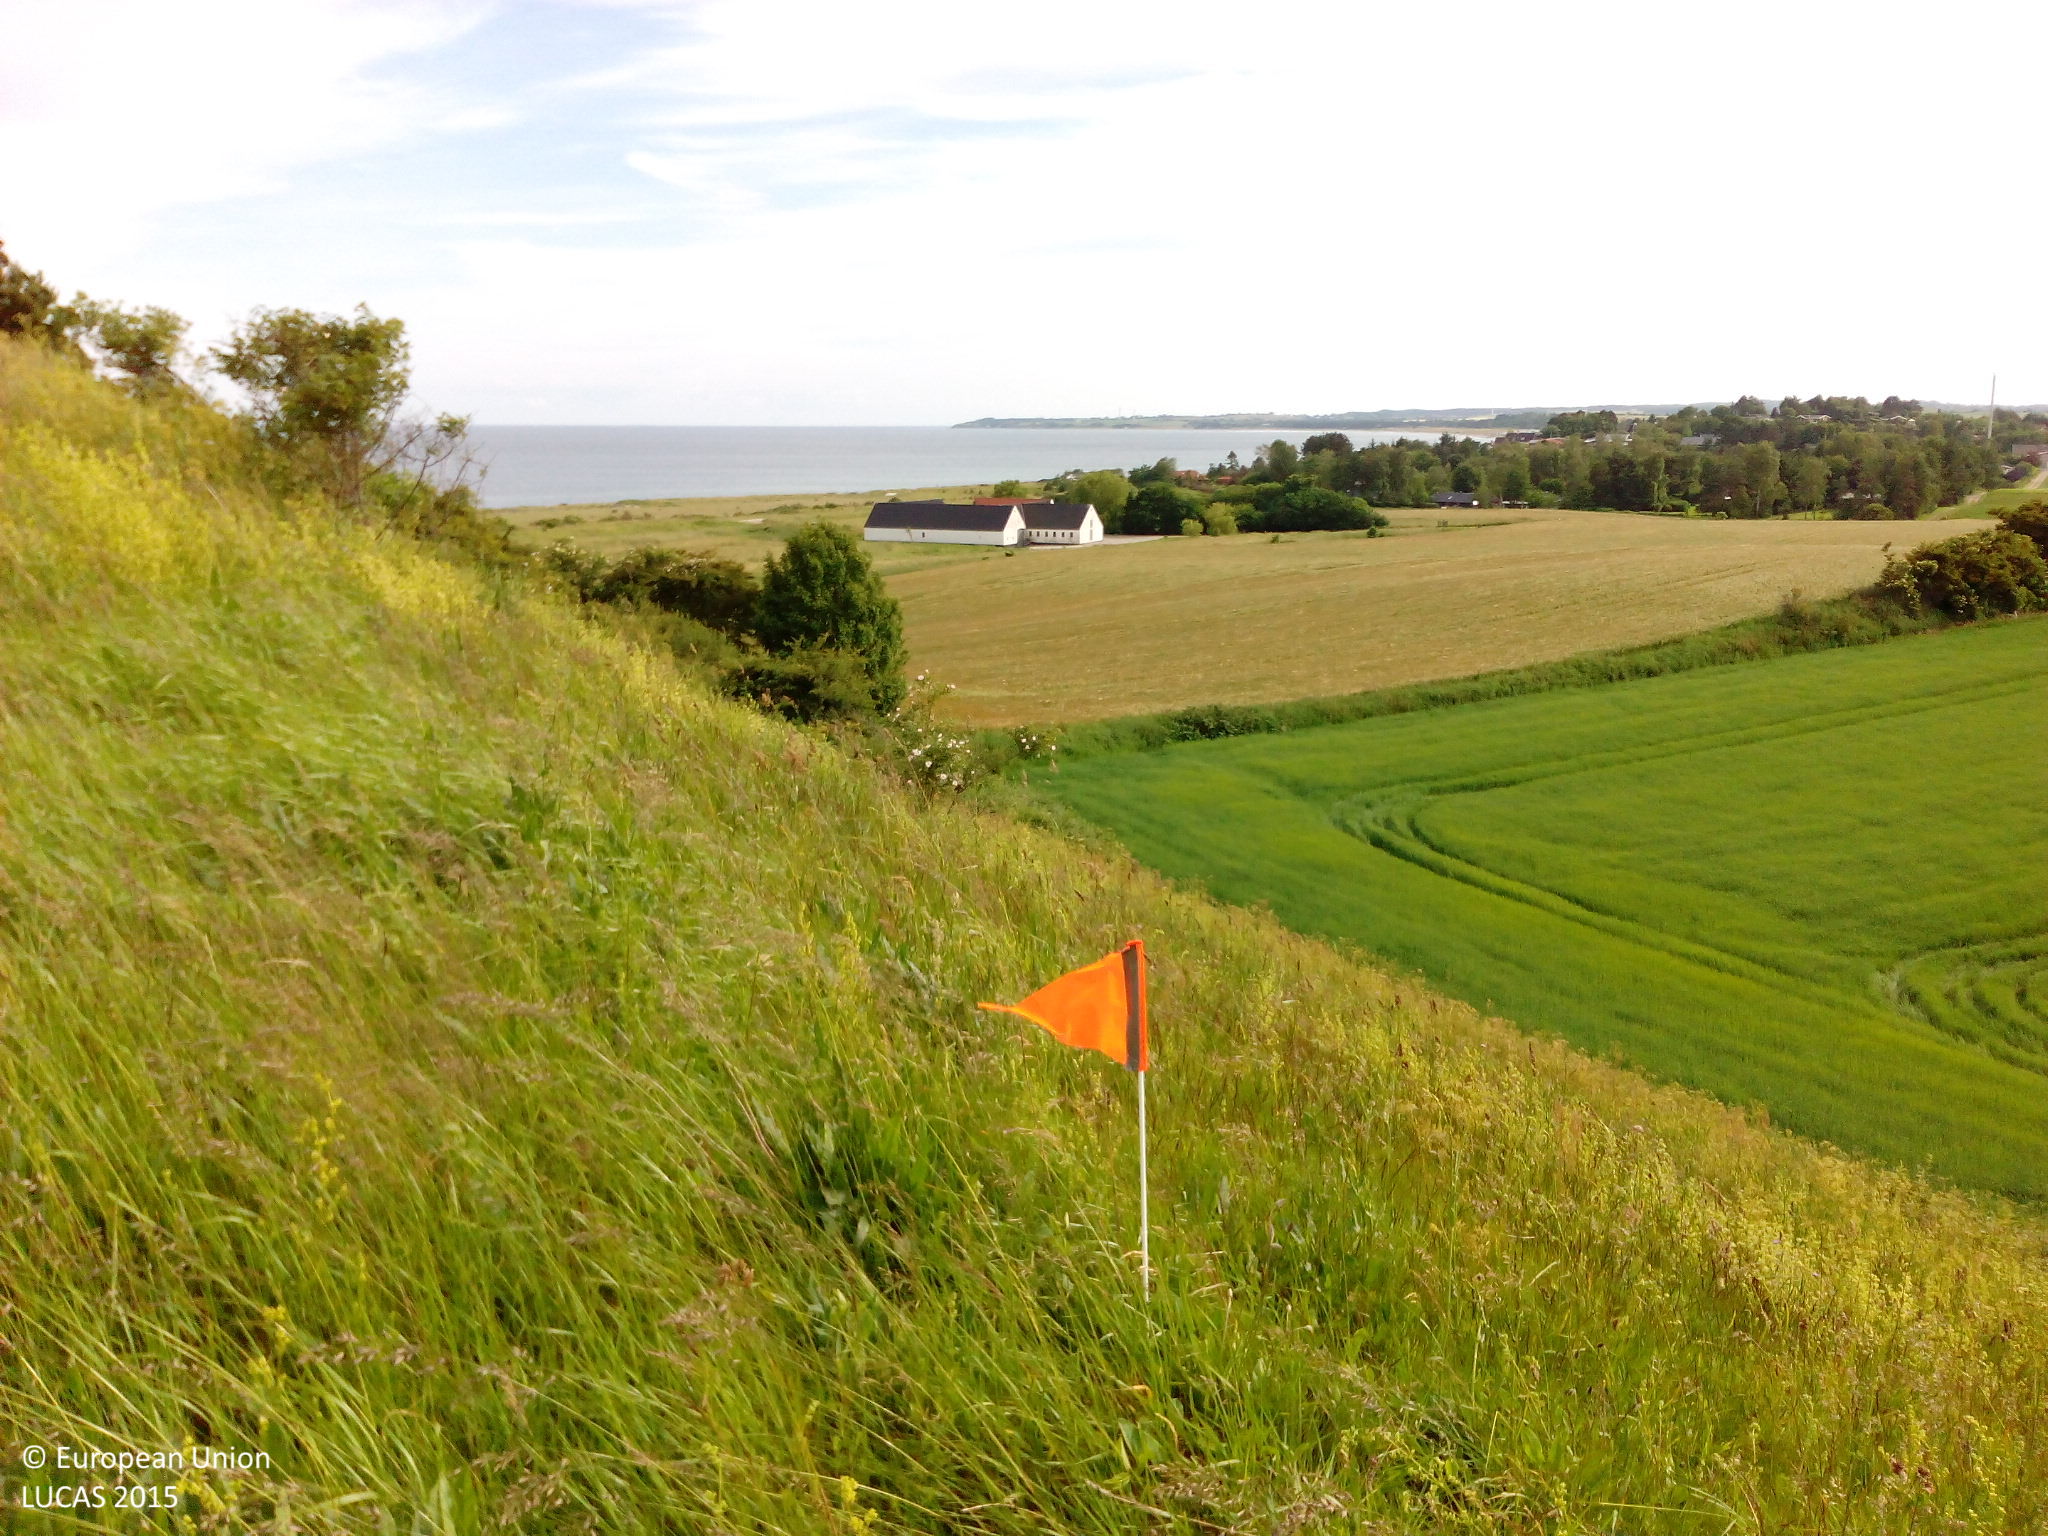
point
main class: Grassland
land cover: Grassland without tree/shrub cover
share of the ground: > 75 %
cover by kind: herbaceous plants 100 %
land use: Semi-natural and natural areas not in use
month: June
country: DK
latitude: 56.2394
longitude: 10.7574
